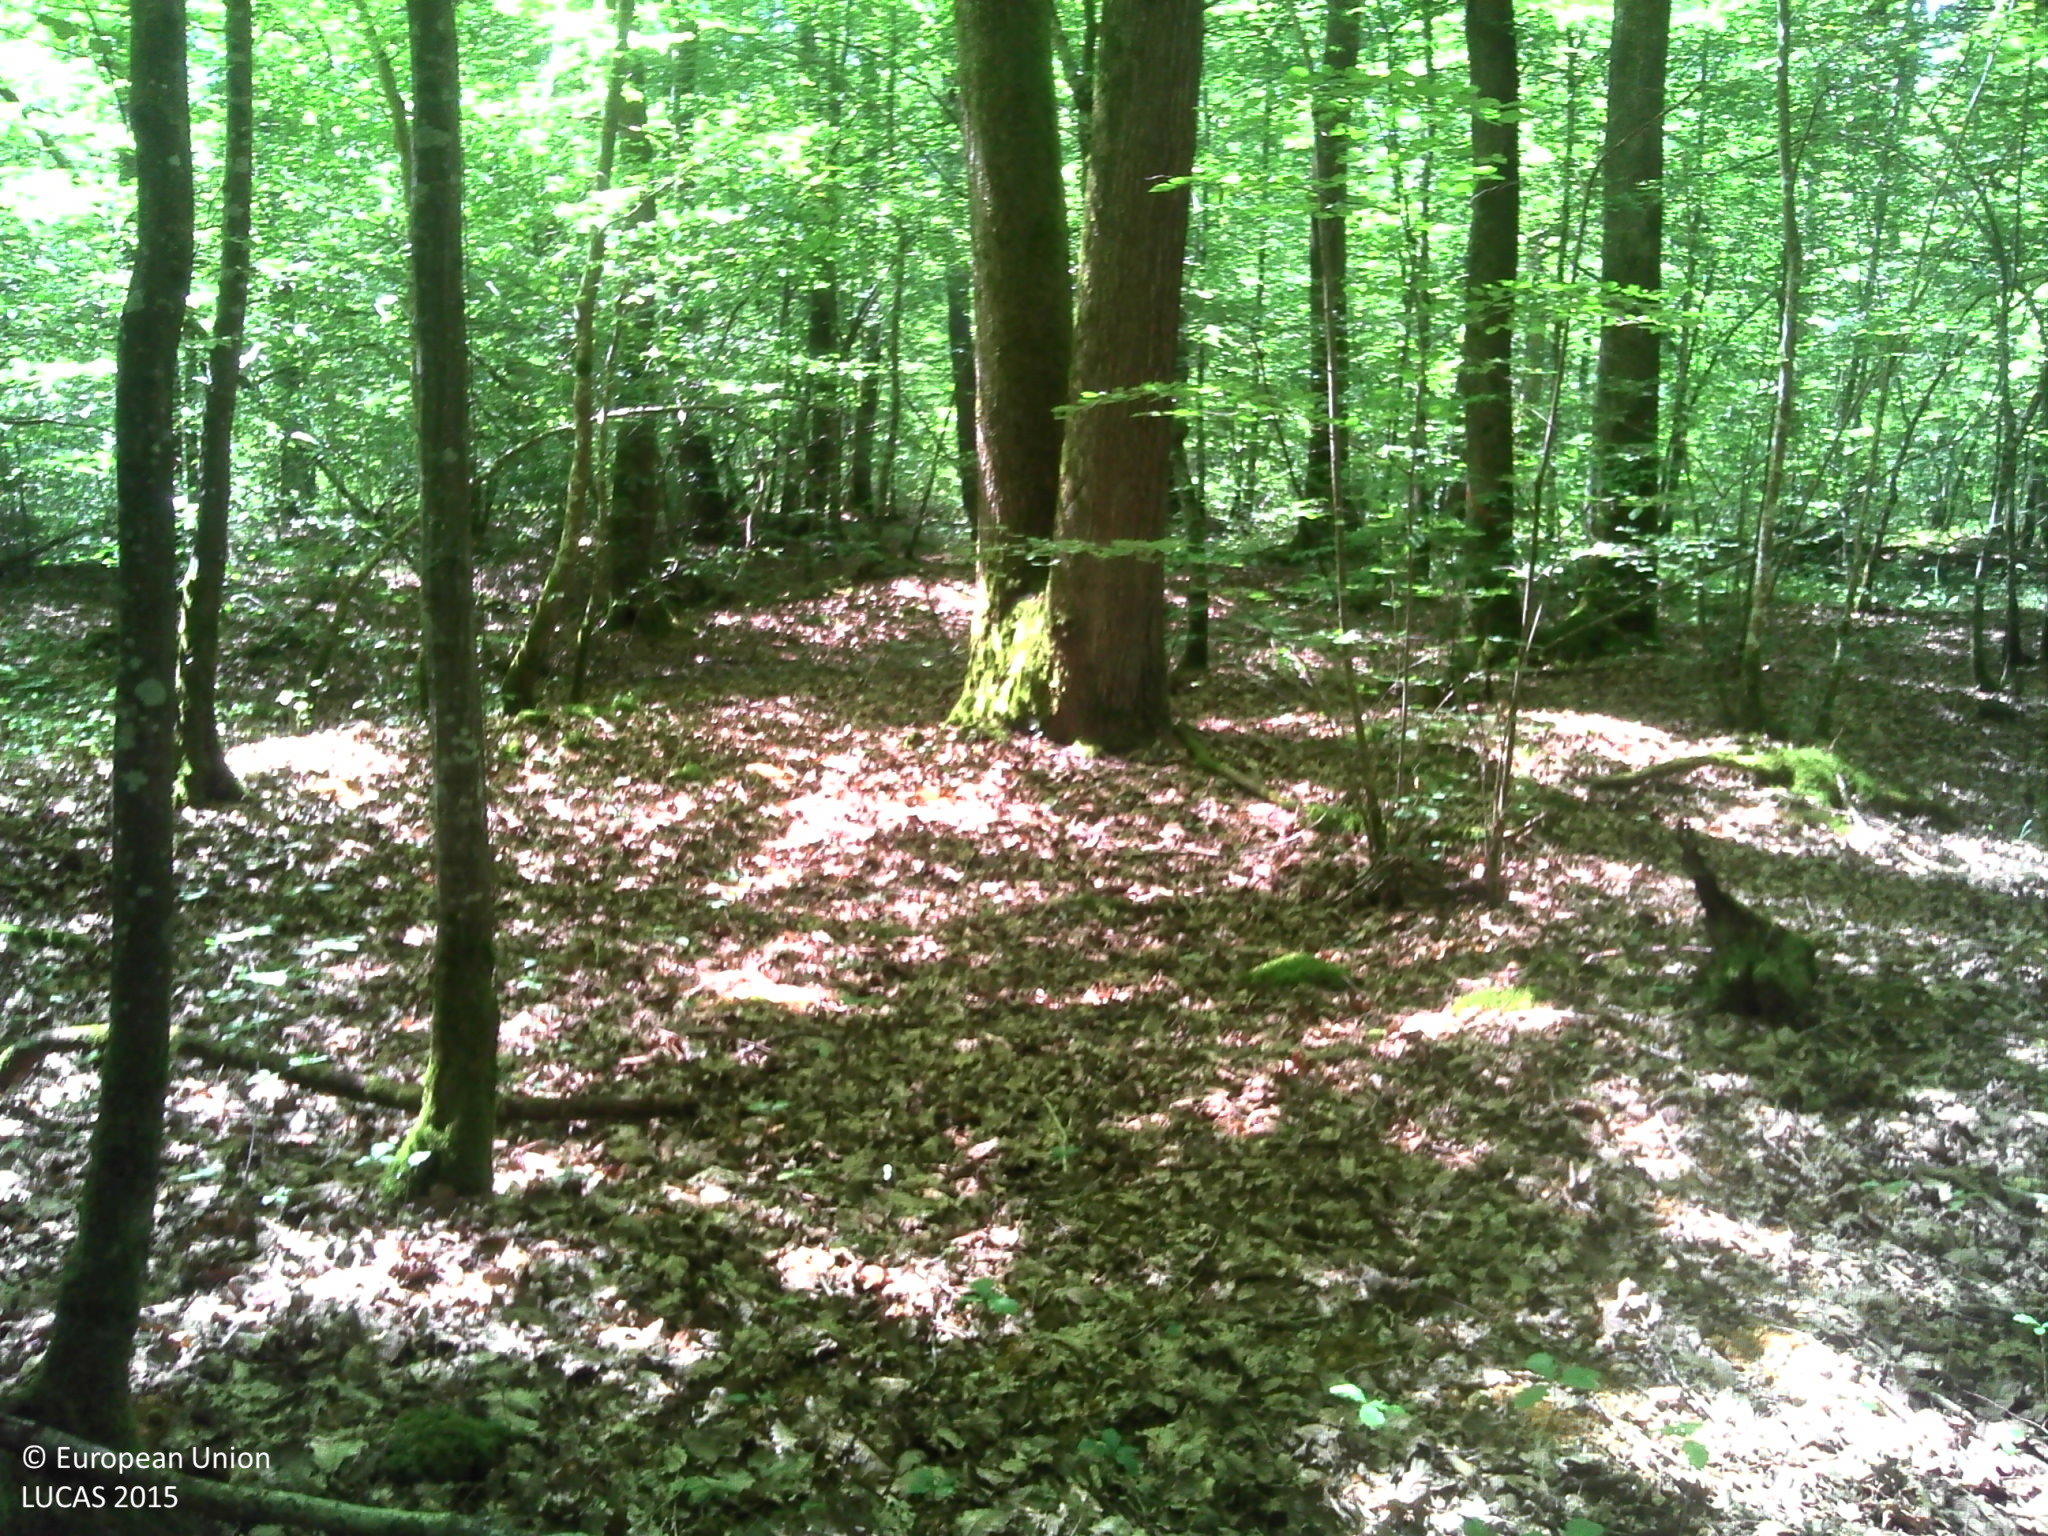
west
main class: Woodland
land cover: Broadleaved woodland
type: mesophytic deciduous forest
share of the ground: > 75 %
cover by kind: broadleaved forest trees 90 %, herbaceous plants 5 %, lichens and mosses 5 %
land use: Forestry
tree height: > 5 m
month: June
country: FR
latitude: 47.4772
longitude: 3.5874
